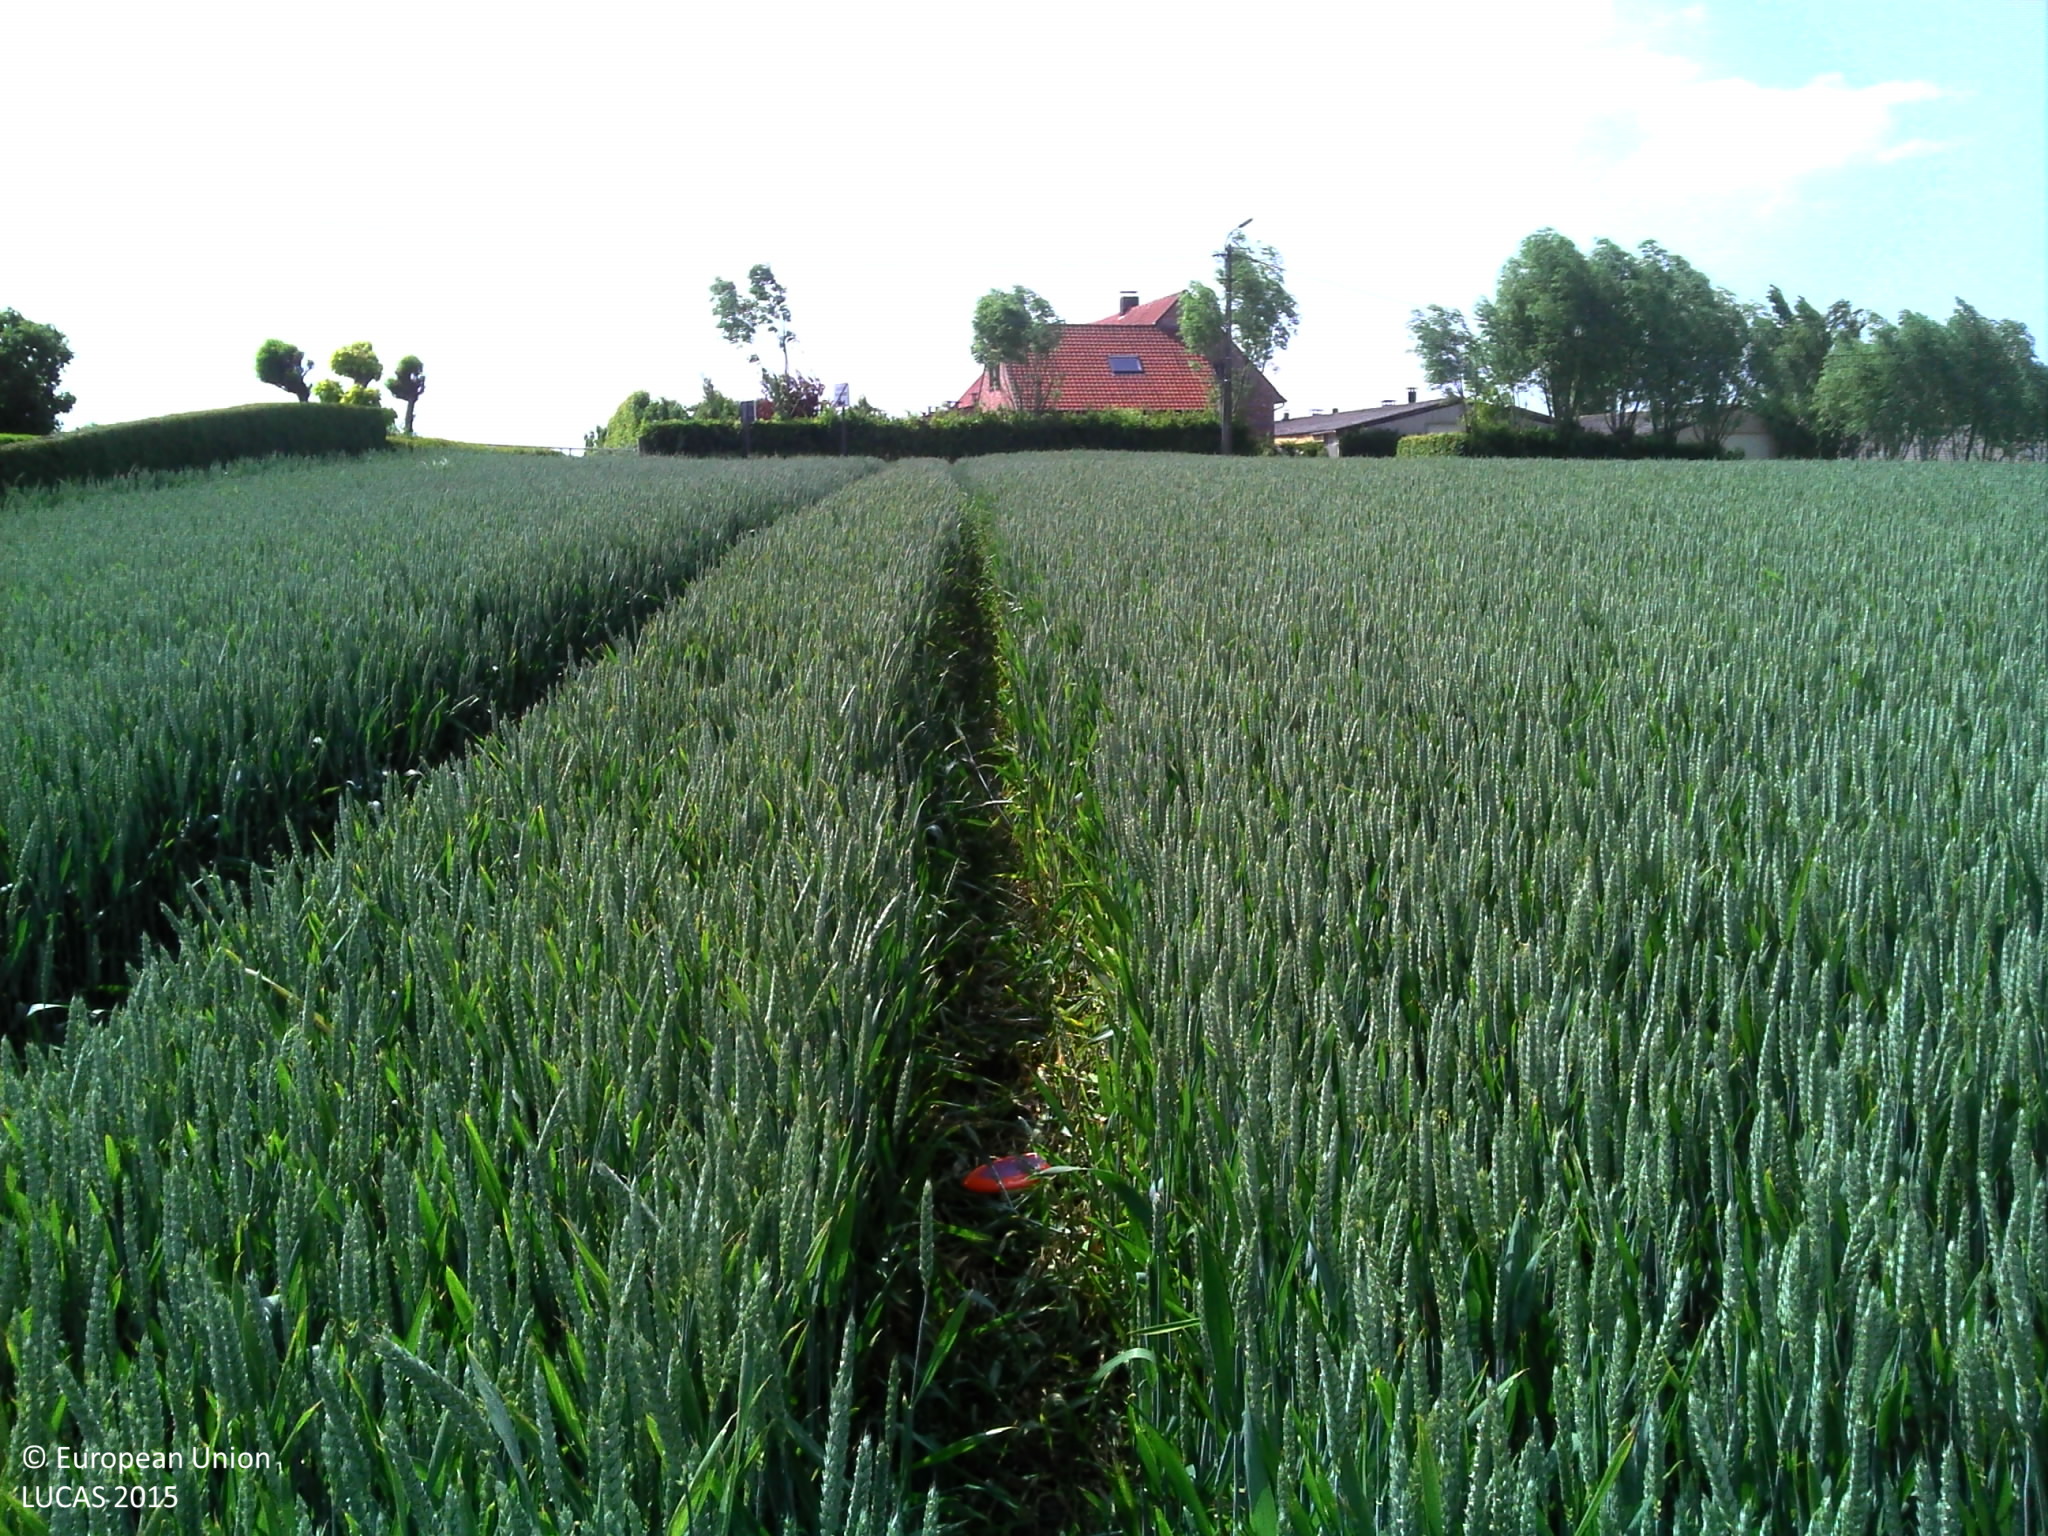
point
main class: Cropland
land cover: Common wheat
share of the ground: > 75 %
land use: Agriculture (excluding fallow land and kitchen gardens)
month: June
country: BE
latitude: 50.7885
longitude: 2.8255
